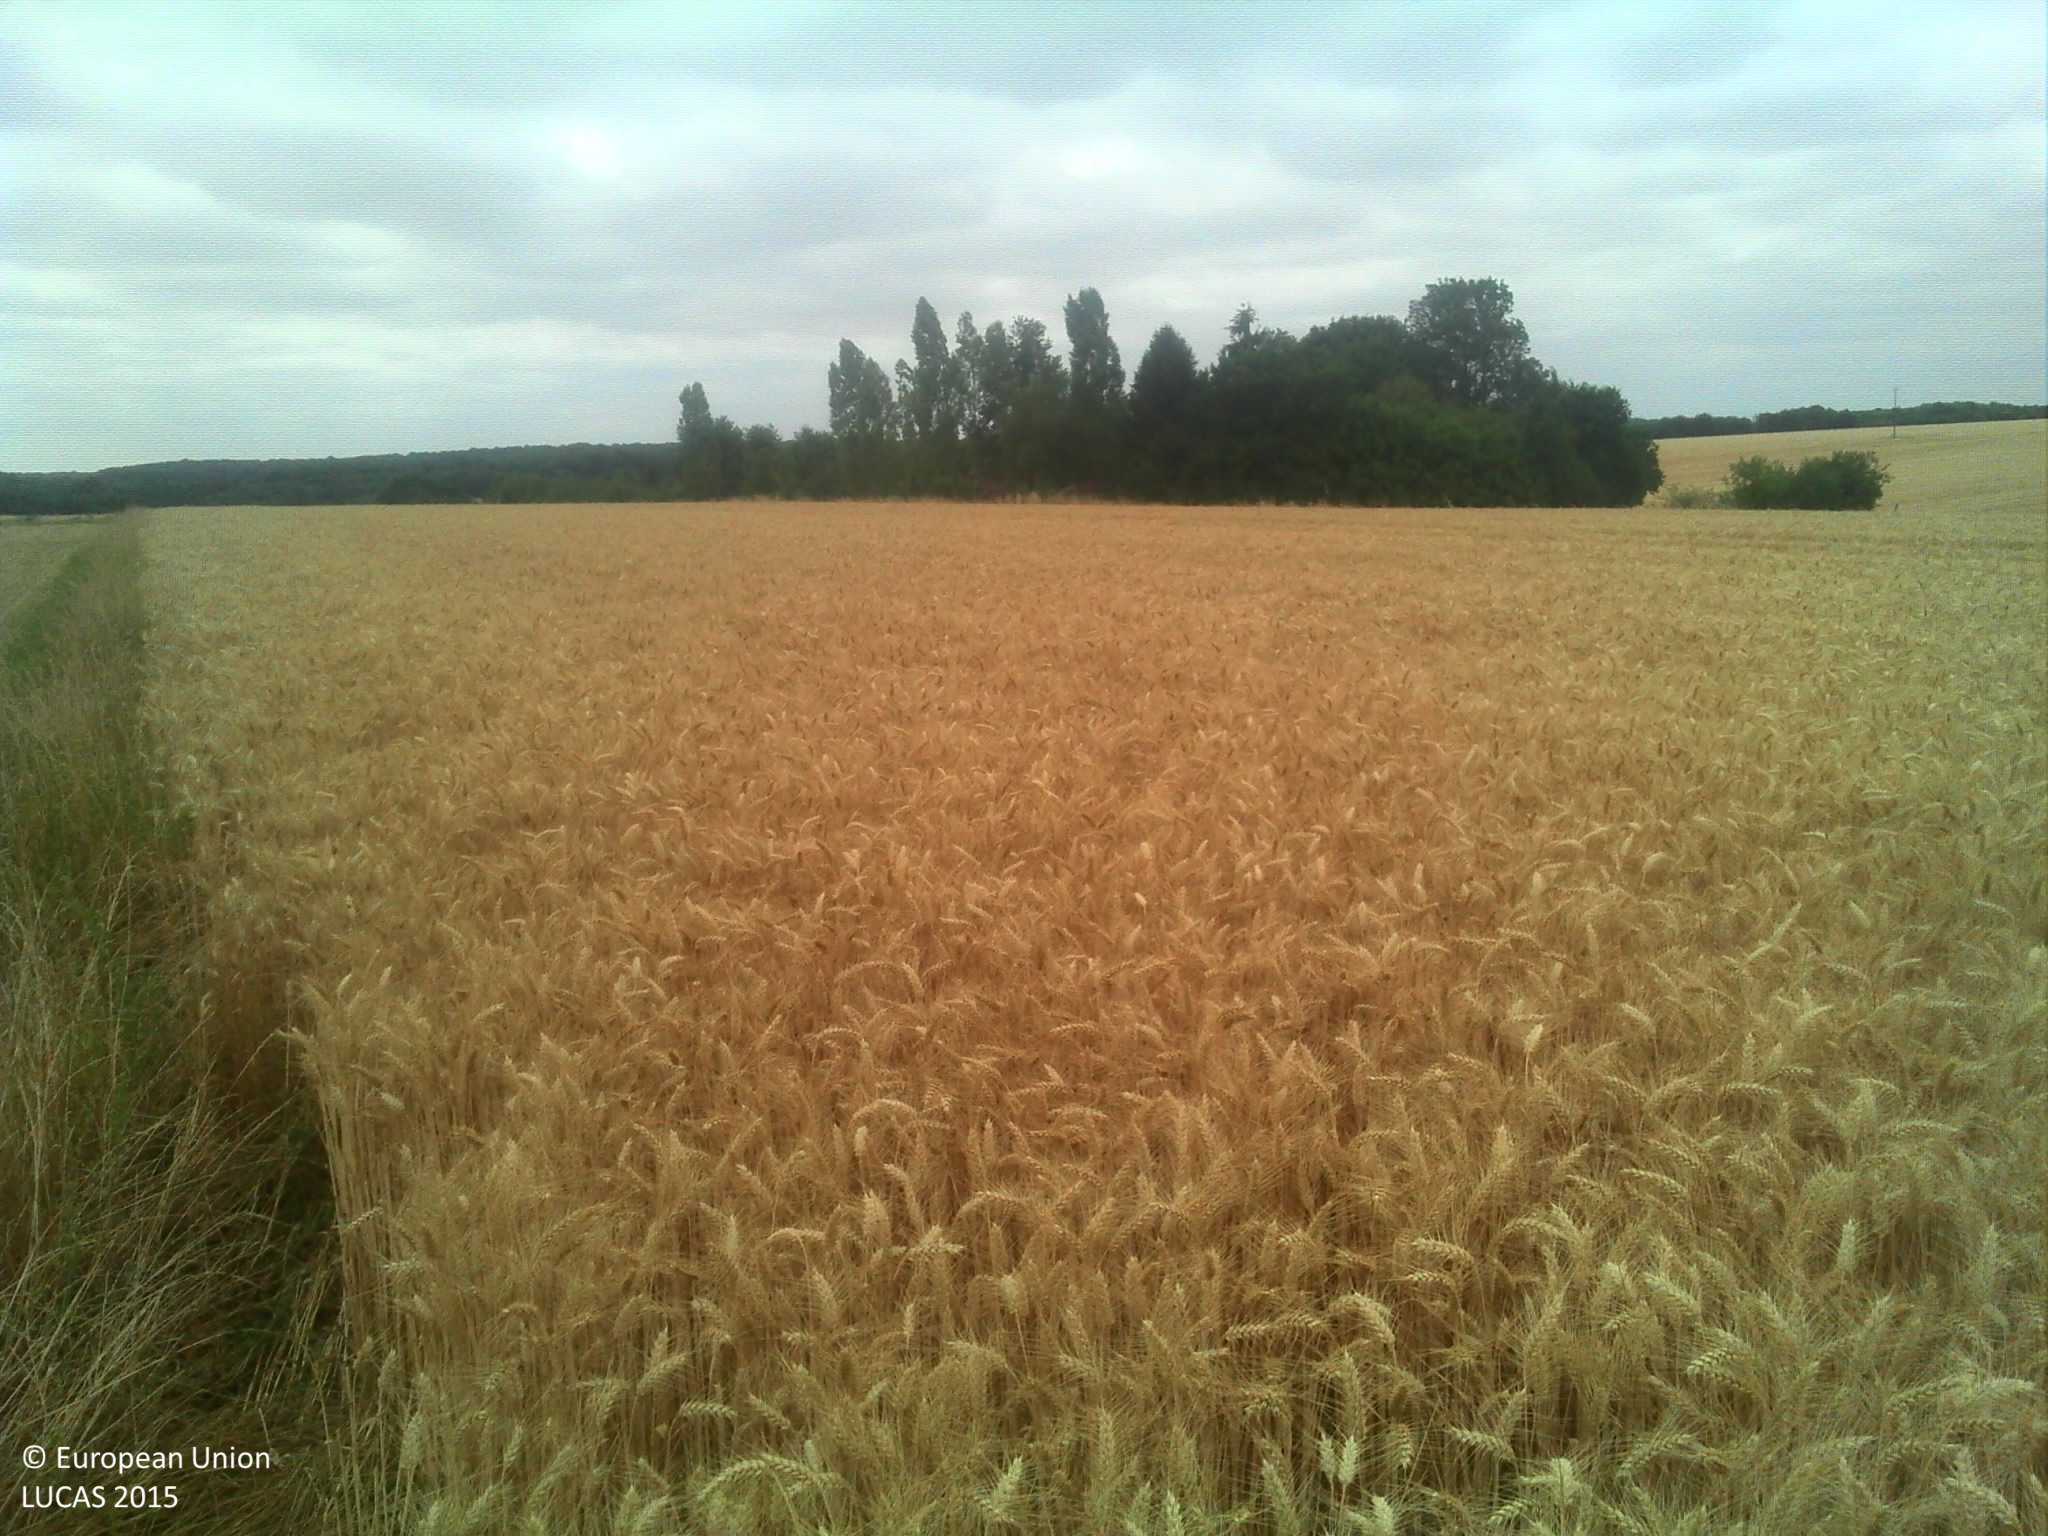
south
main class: Cropland
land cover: Common wheat
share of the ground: > 75 %
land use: Agriculture (excluding fallow land and kitchen gardens)
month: July
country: FR
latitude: 47.7244
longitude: 0.7407
